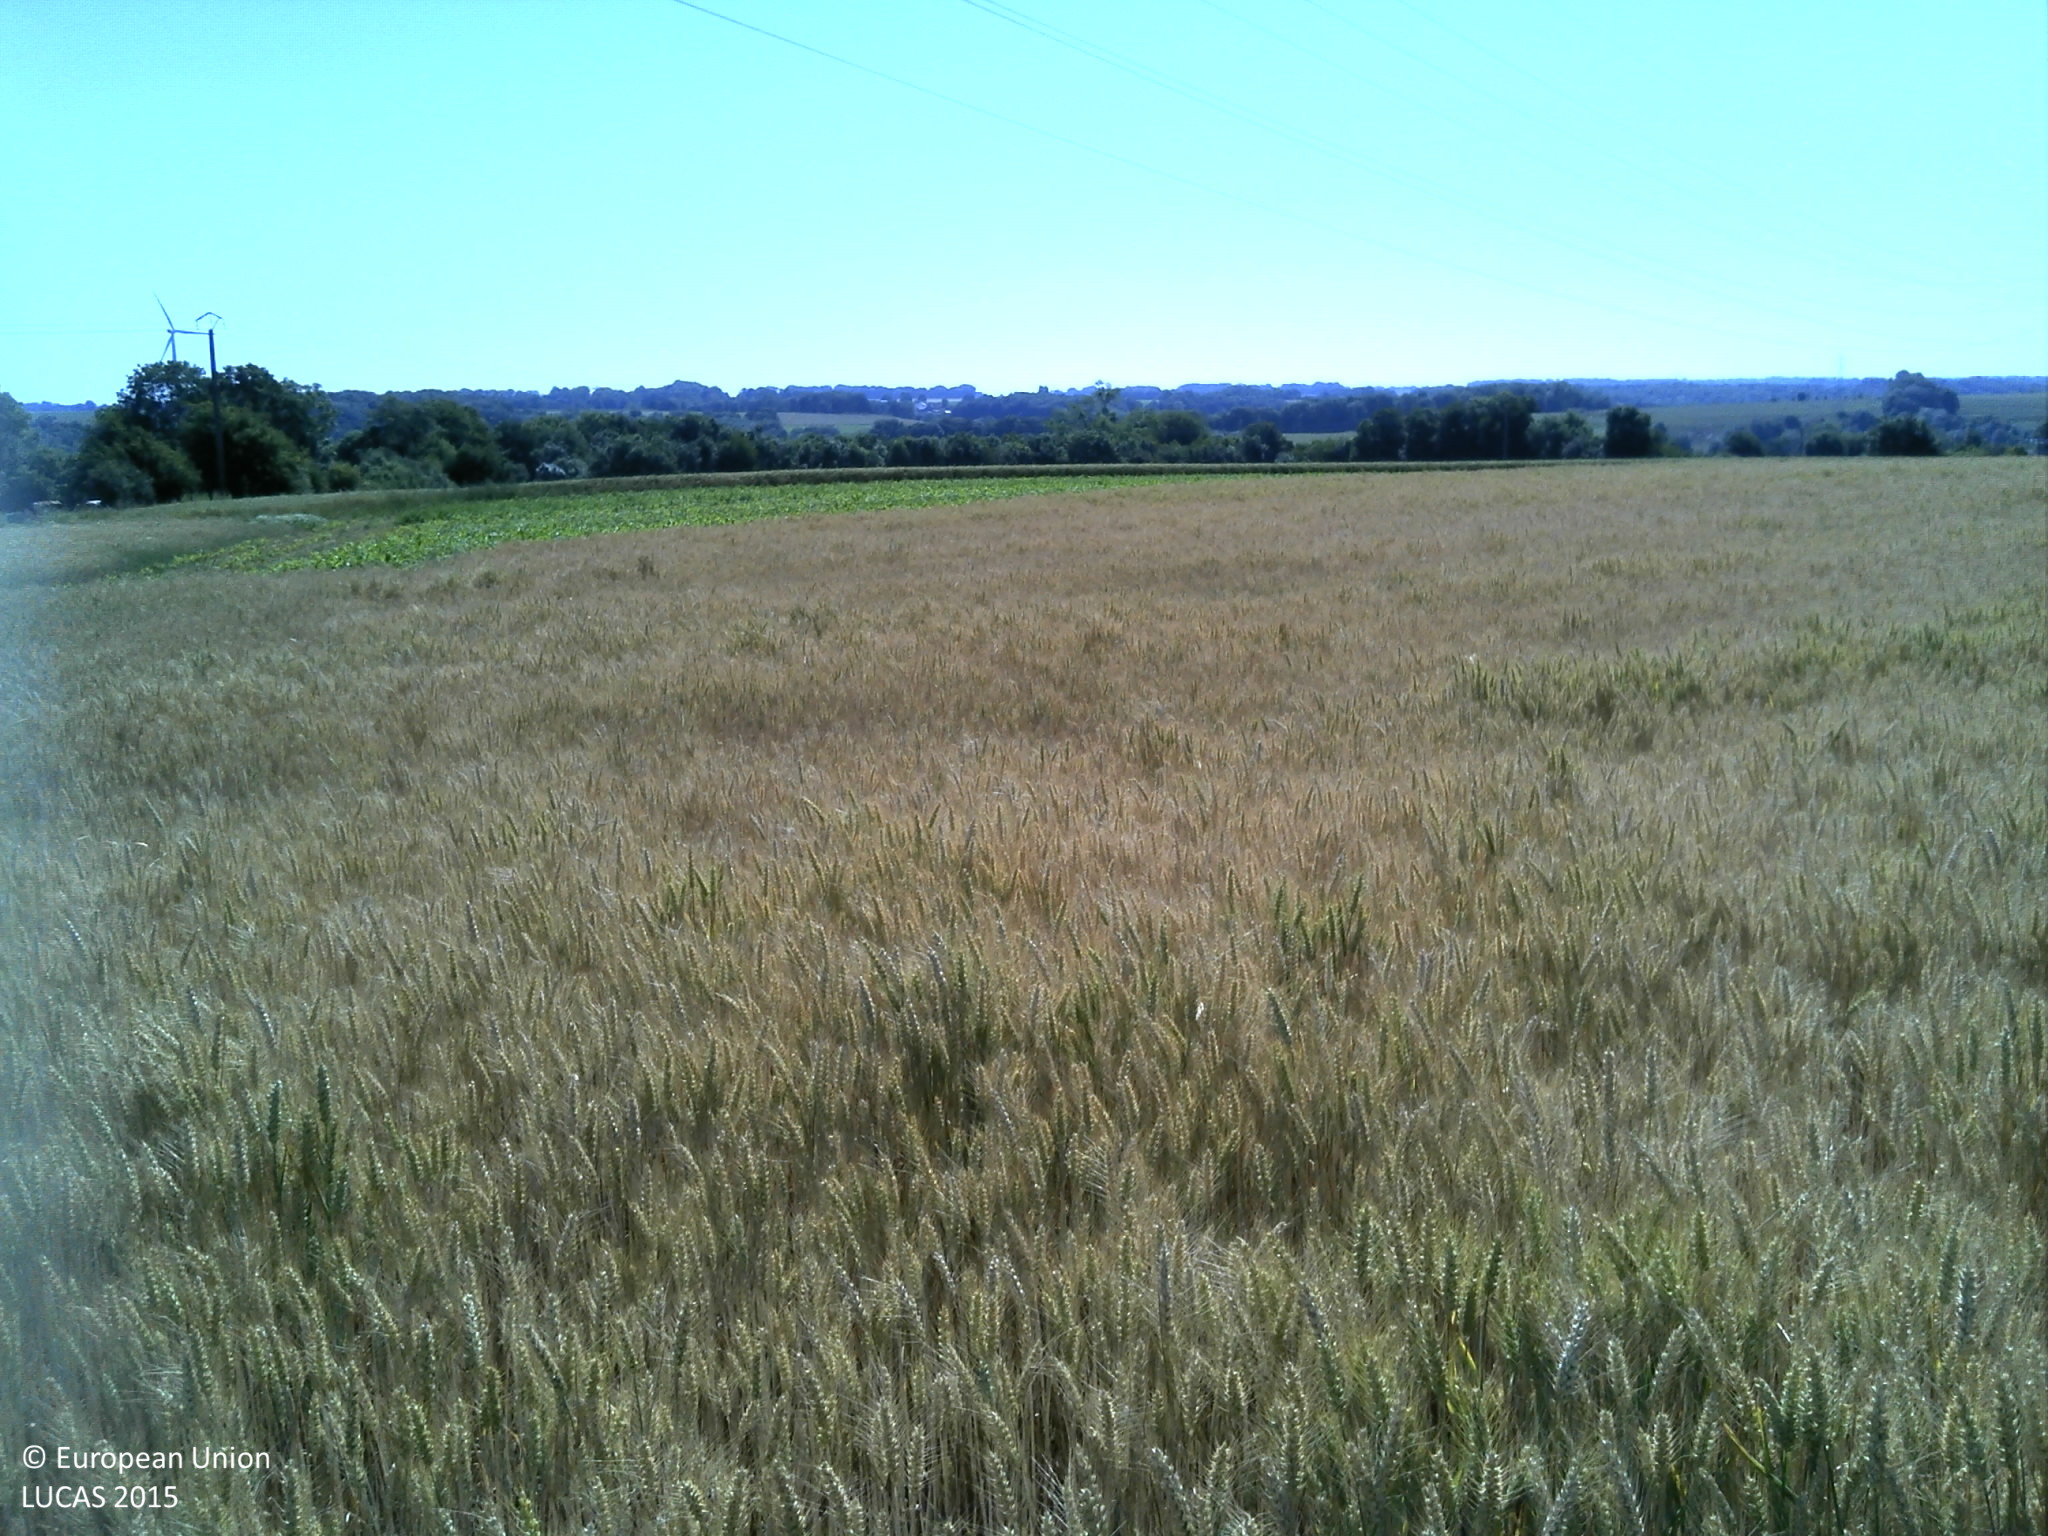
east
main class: Cropland
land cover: Durum wheat
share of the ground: > 75 %
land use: Agriculture (excluding fallow land and kitchen gardens)
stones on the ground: 10 - 25 %
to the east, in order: Durum wheat; Electric lines; Durum wheat; Spontaneously vegetated surfaces; Common wheat
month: June
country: FR
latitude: 49.8420
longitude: 0.9523
